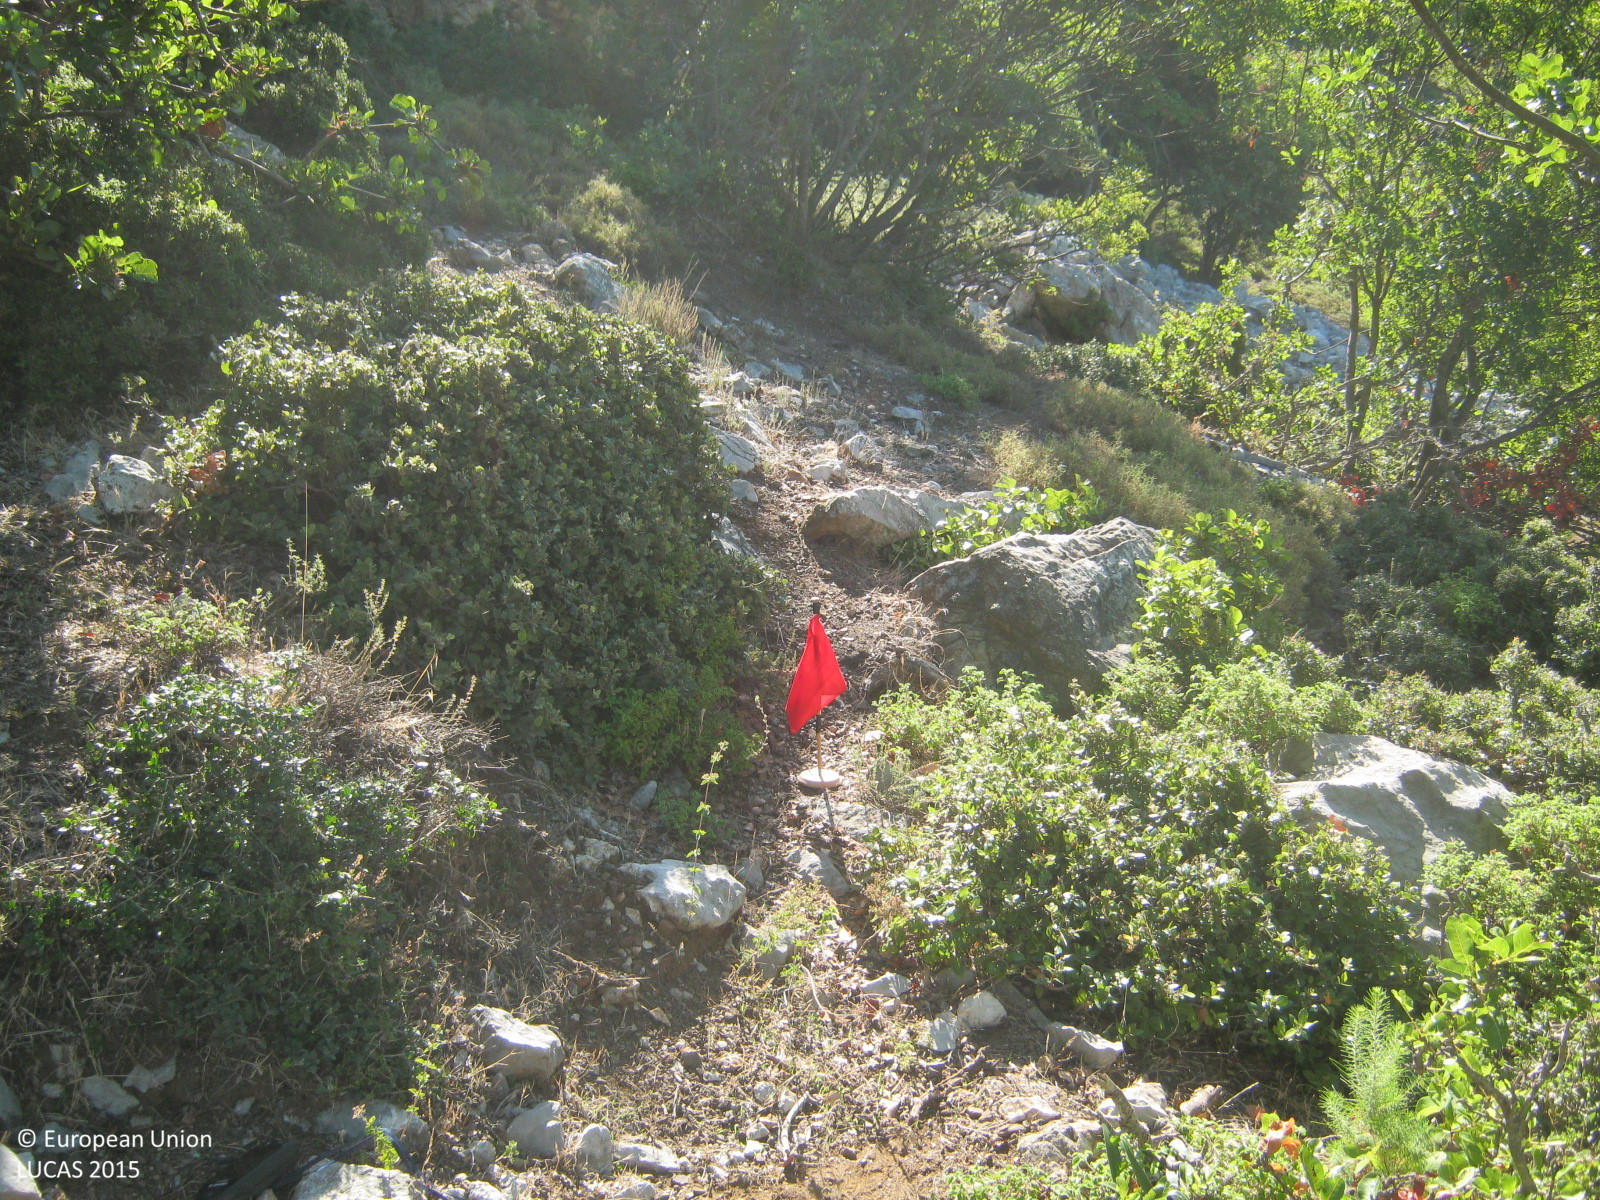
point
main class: Shrubland
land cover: Shrubland with sparse tree cover
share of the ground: > 75 %
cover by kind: shrubs 85 %, herbaceous plants 10 %, broadleaved forest trees 5 %
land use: Semi-natural and natural areas not in use
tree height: < 5 m
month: August
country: GR
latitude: 38.6758
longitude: 23.5869
